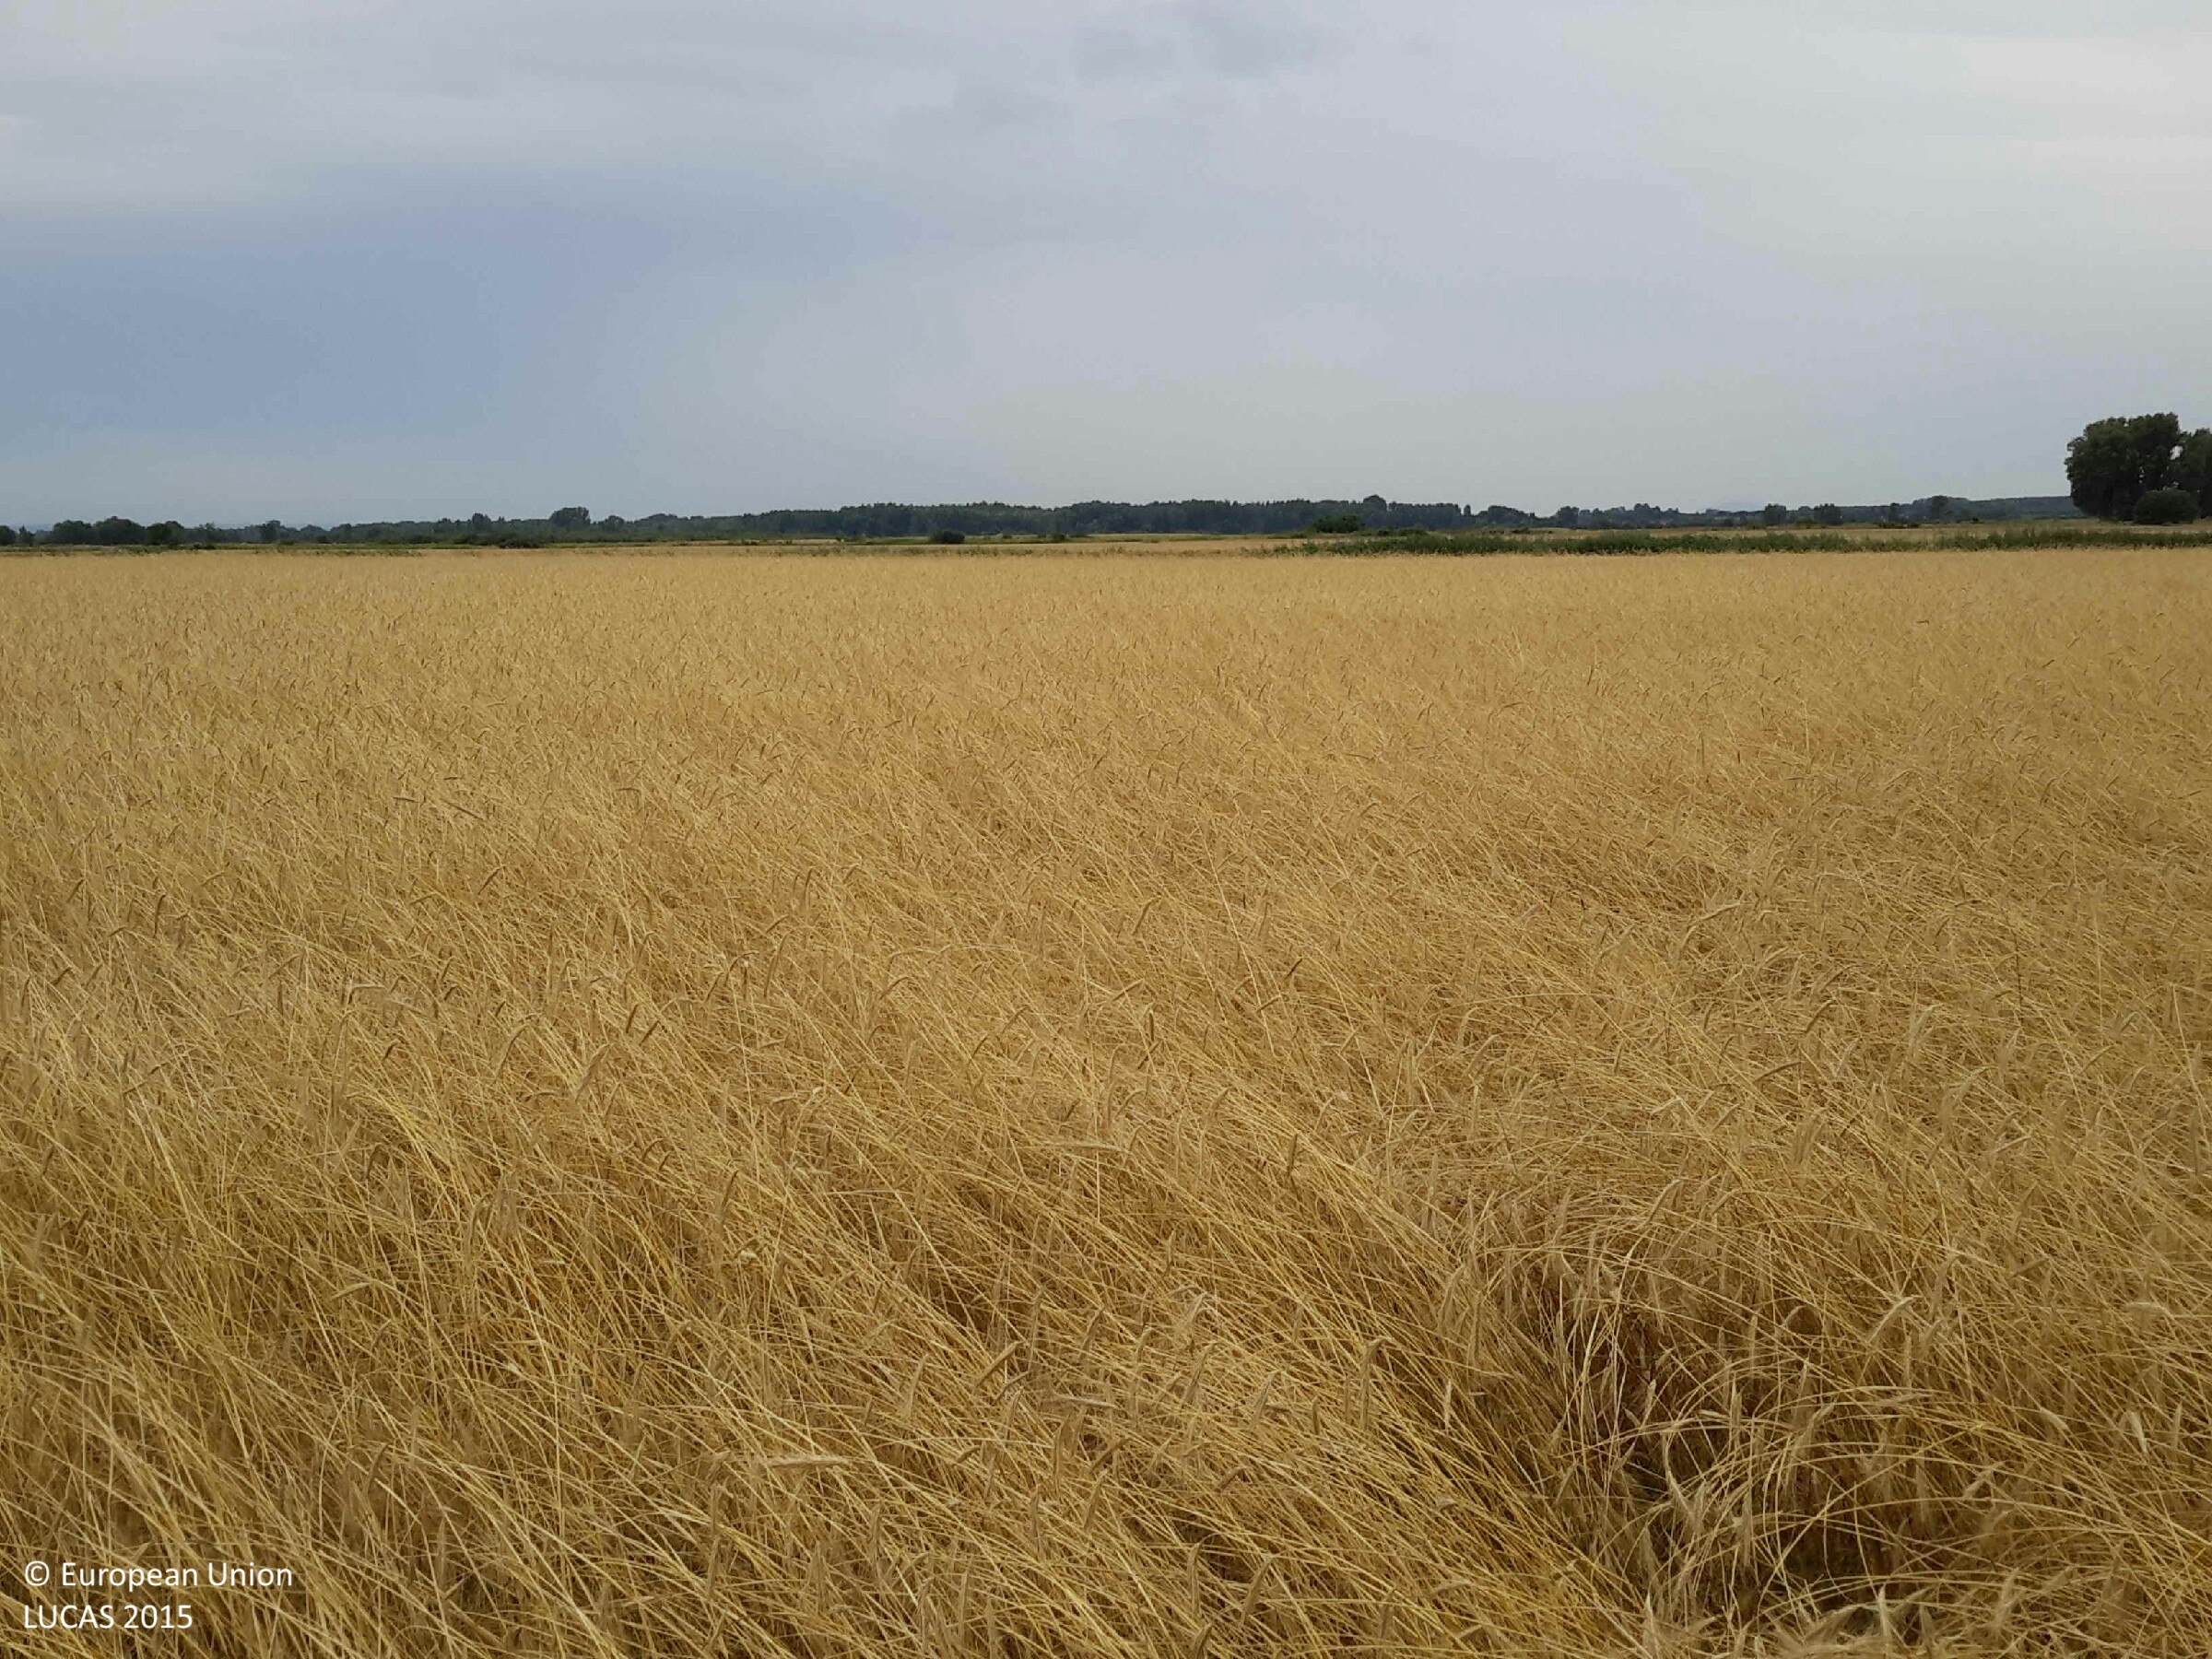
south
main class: Cropland
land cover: Barley
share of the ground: > 75 %
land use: Agriculture (excluding fallow land and kitchen gardens)
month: July
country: HU
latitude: 47.4276
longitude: 17.4714
